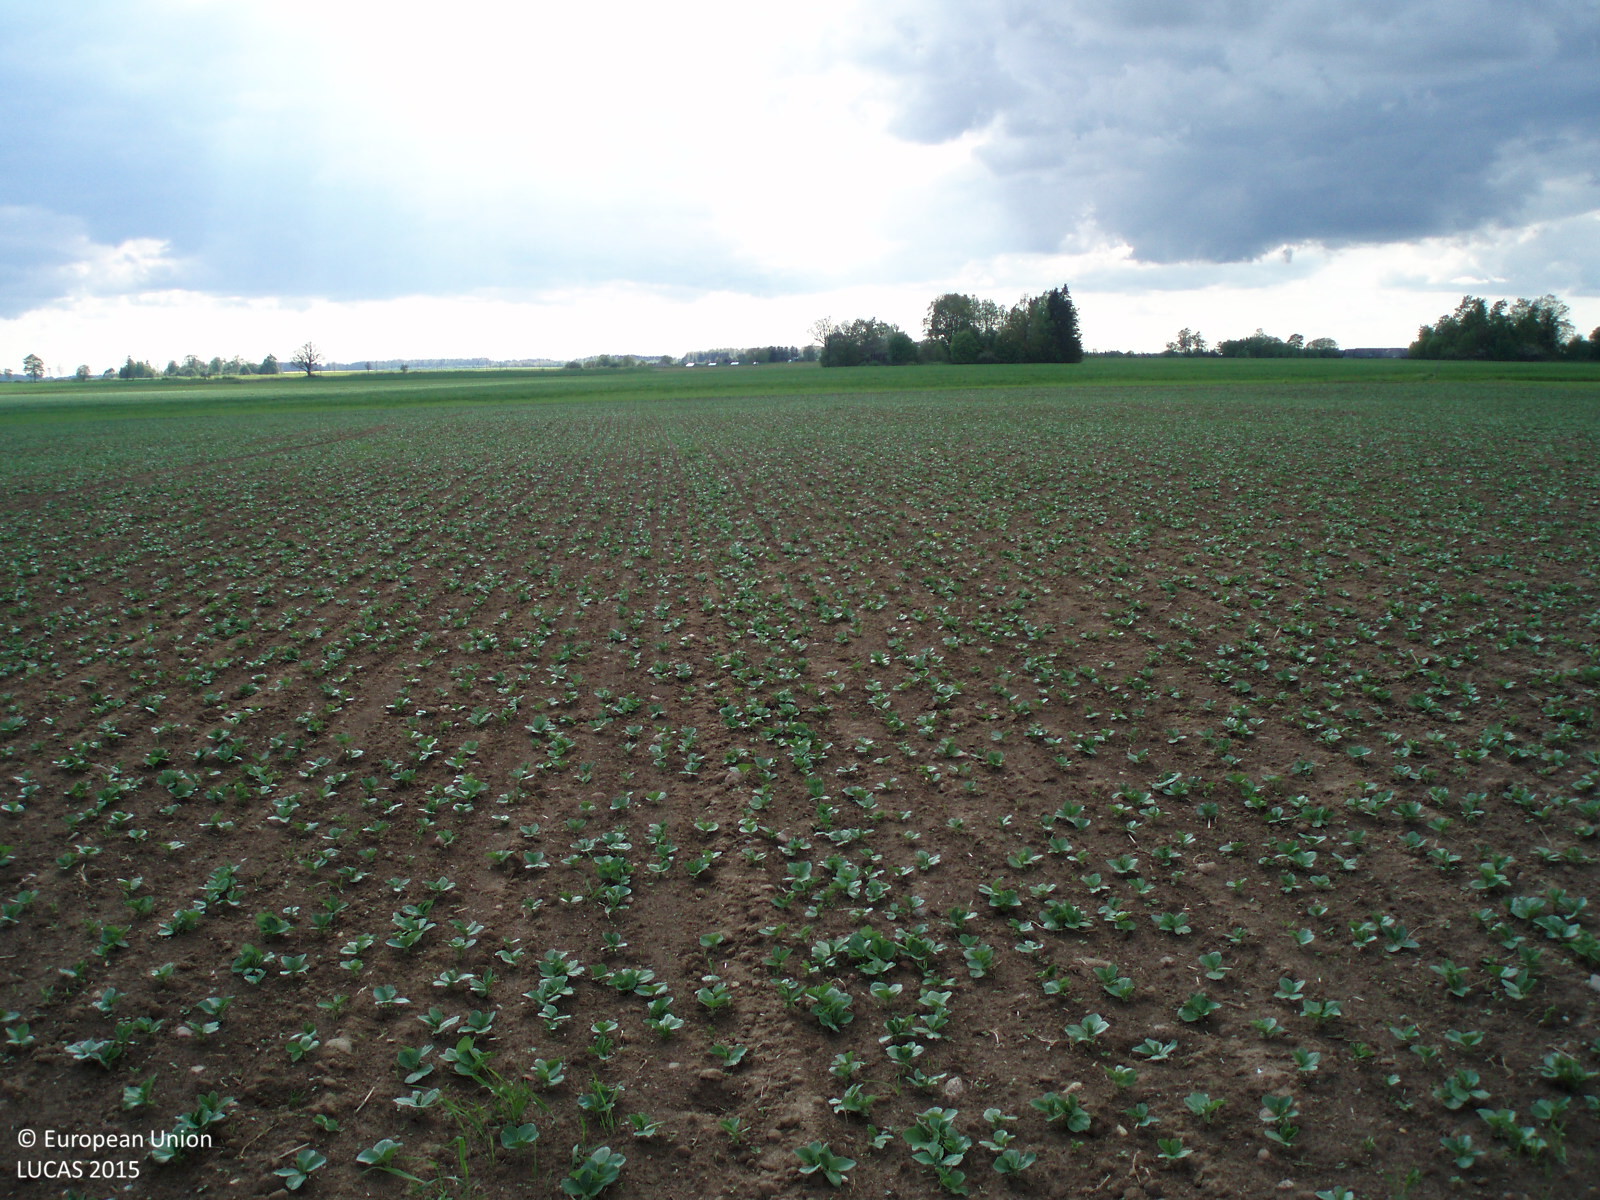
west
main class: Cropland
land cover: Dry pulses
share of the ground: 25 - 50 %
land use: Agriculture (excluding fallow land and kitchen gardens)
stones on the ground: < 10 %
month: May
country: LT
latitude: 56.3680
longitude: 22.5732
